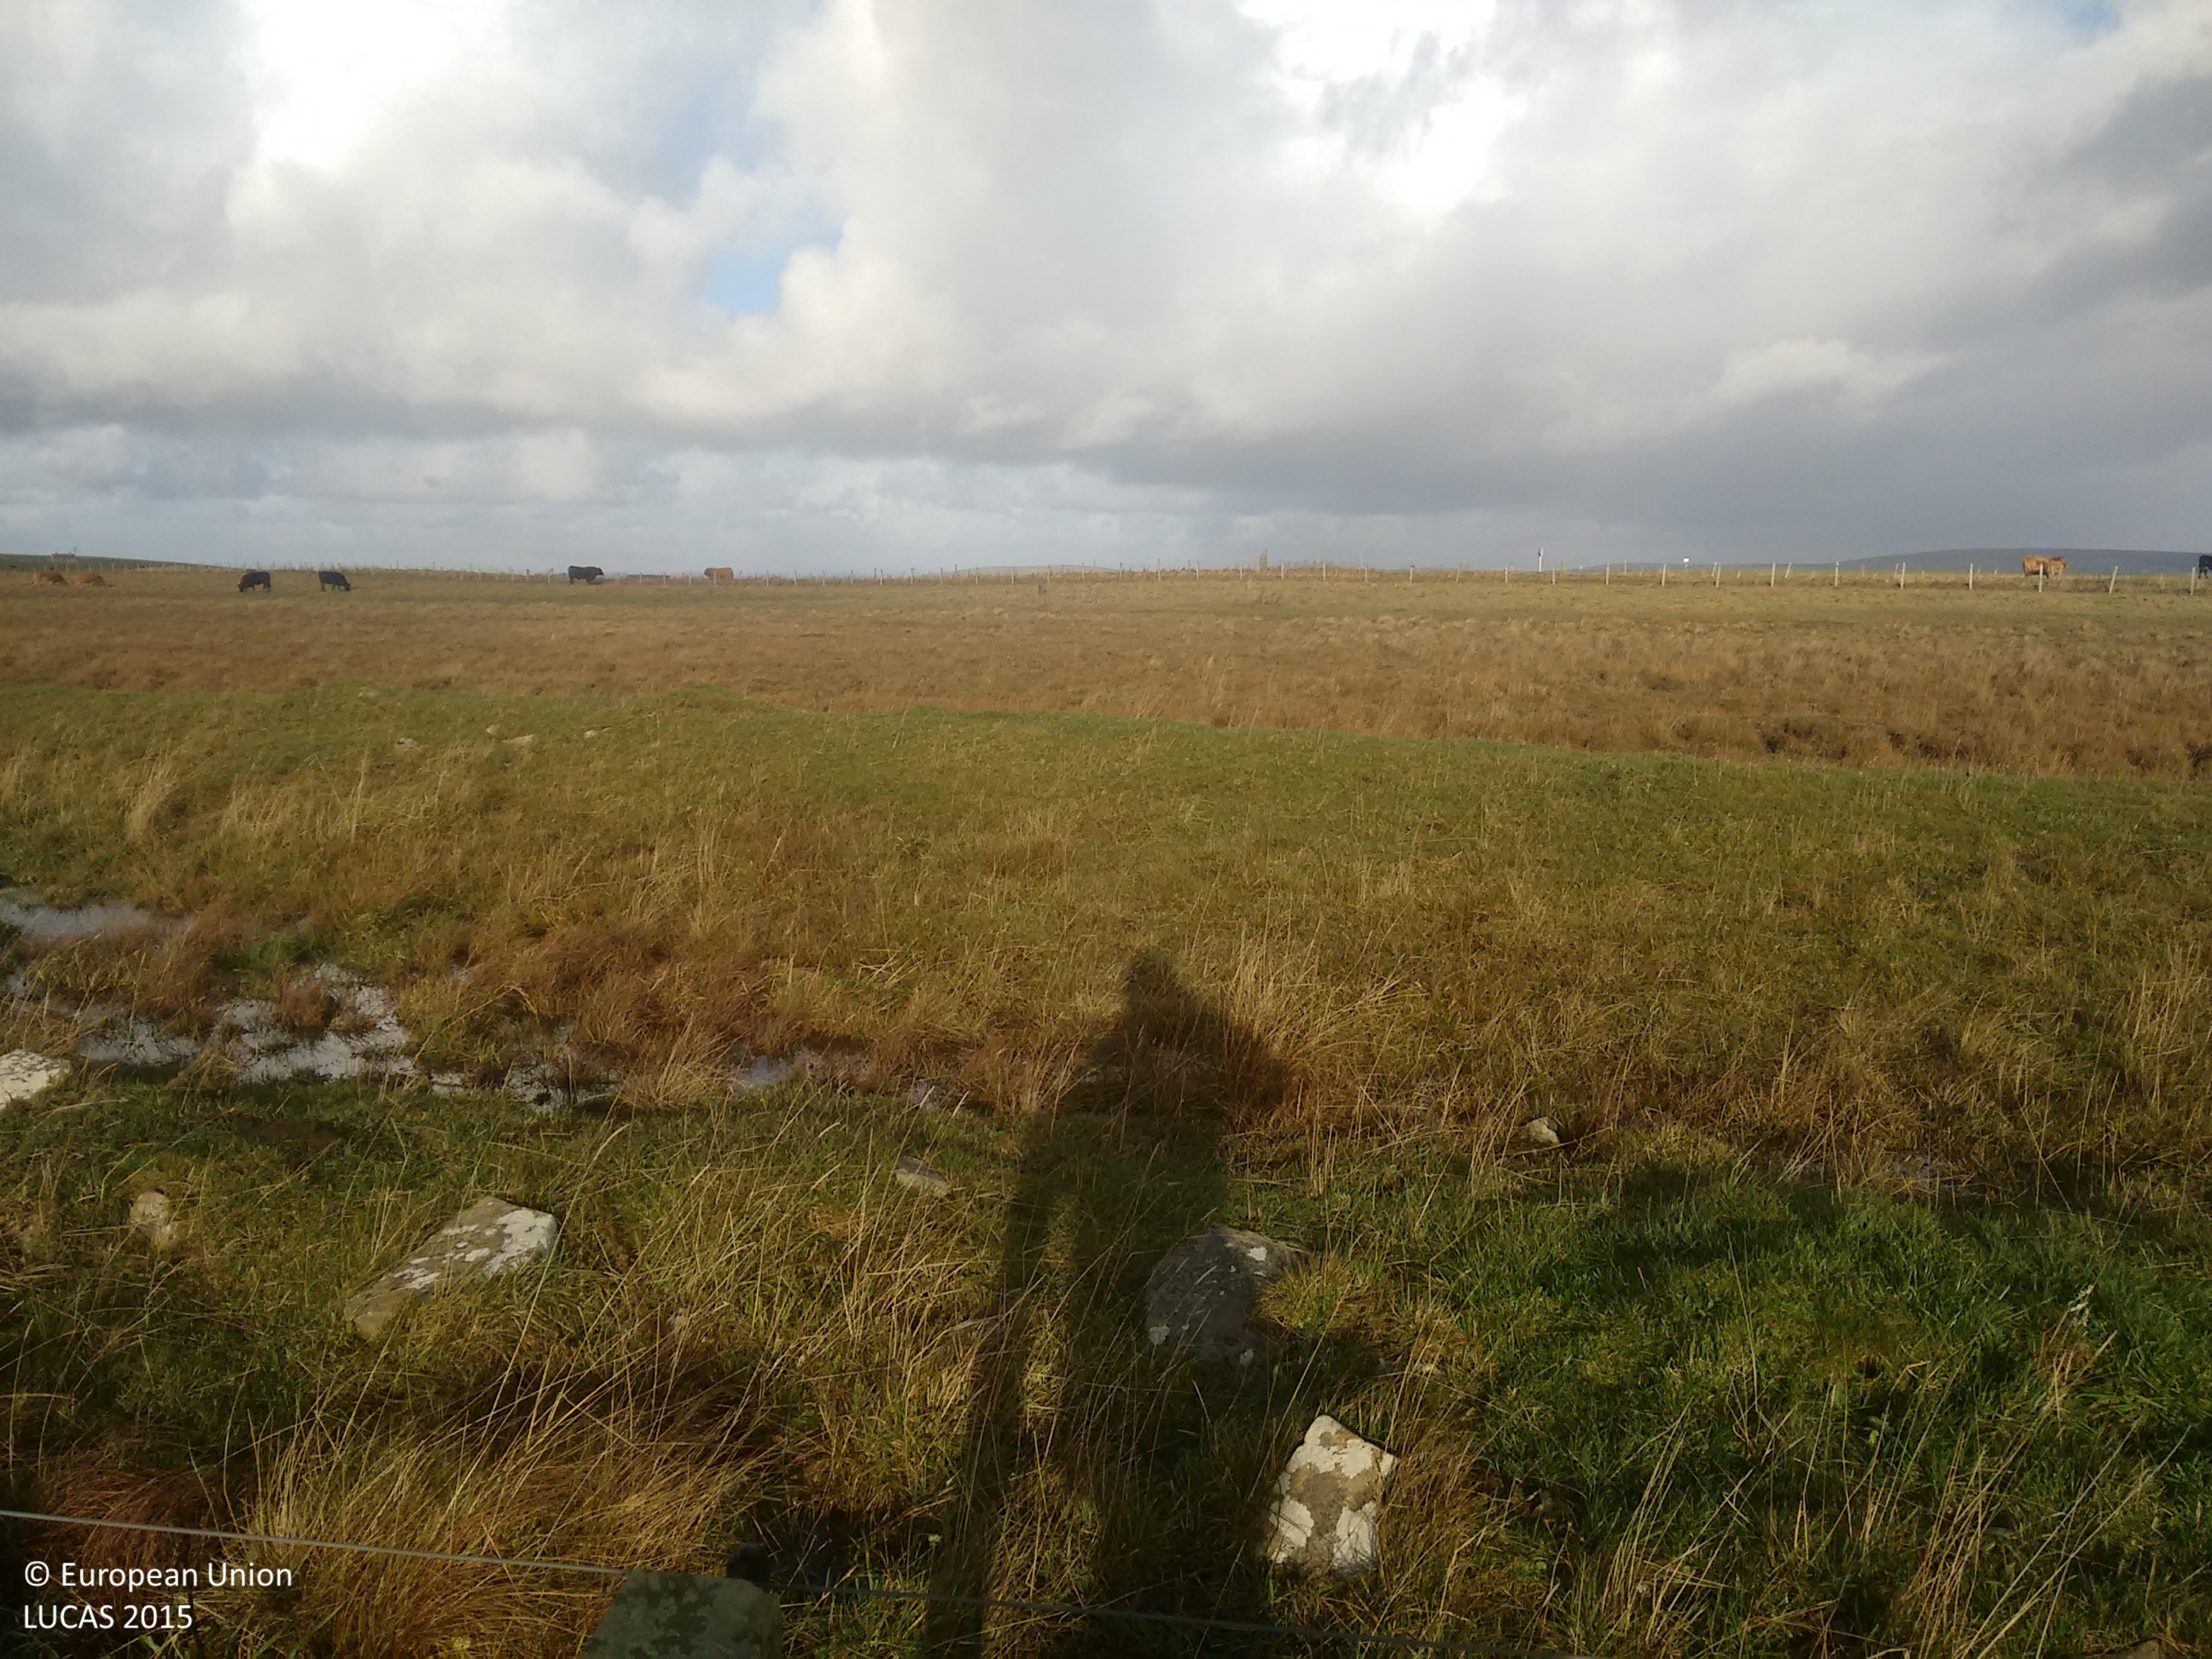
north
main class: Grassland
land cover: Grassland without tree/shrub cover
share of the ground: > 75 %
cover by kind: herbaceous plants 100 %
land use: Agriculture (excluding fallow land and kitchen gardens)
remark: Temporary flooded
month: November
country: GB
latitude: 59.0046
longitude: -3.2357
